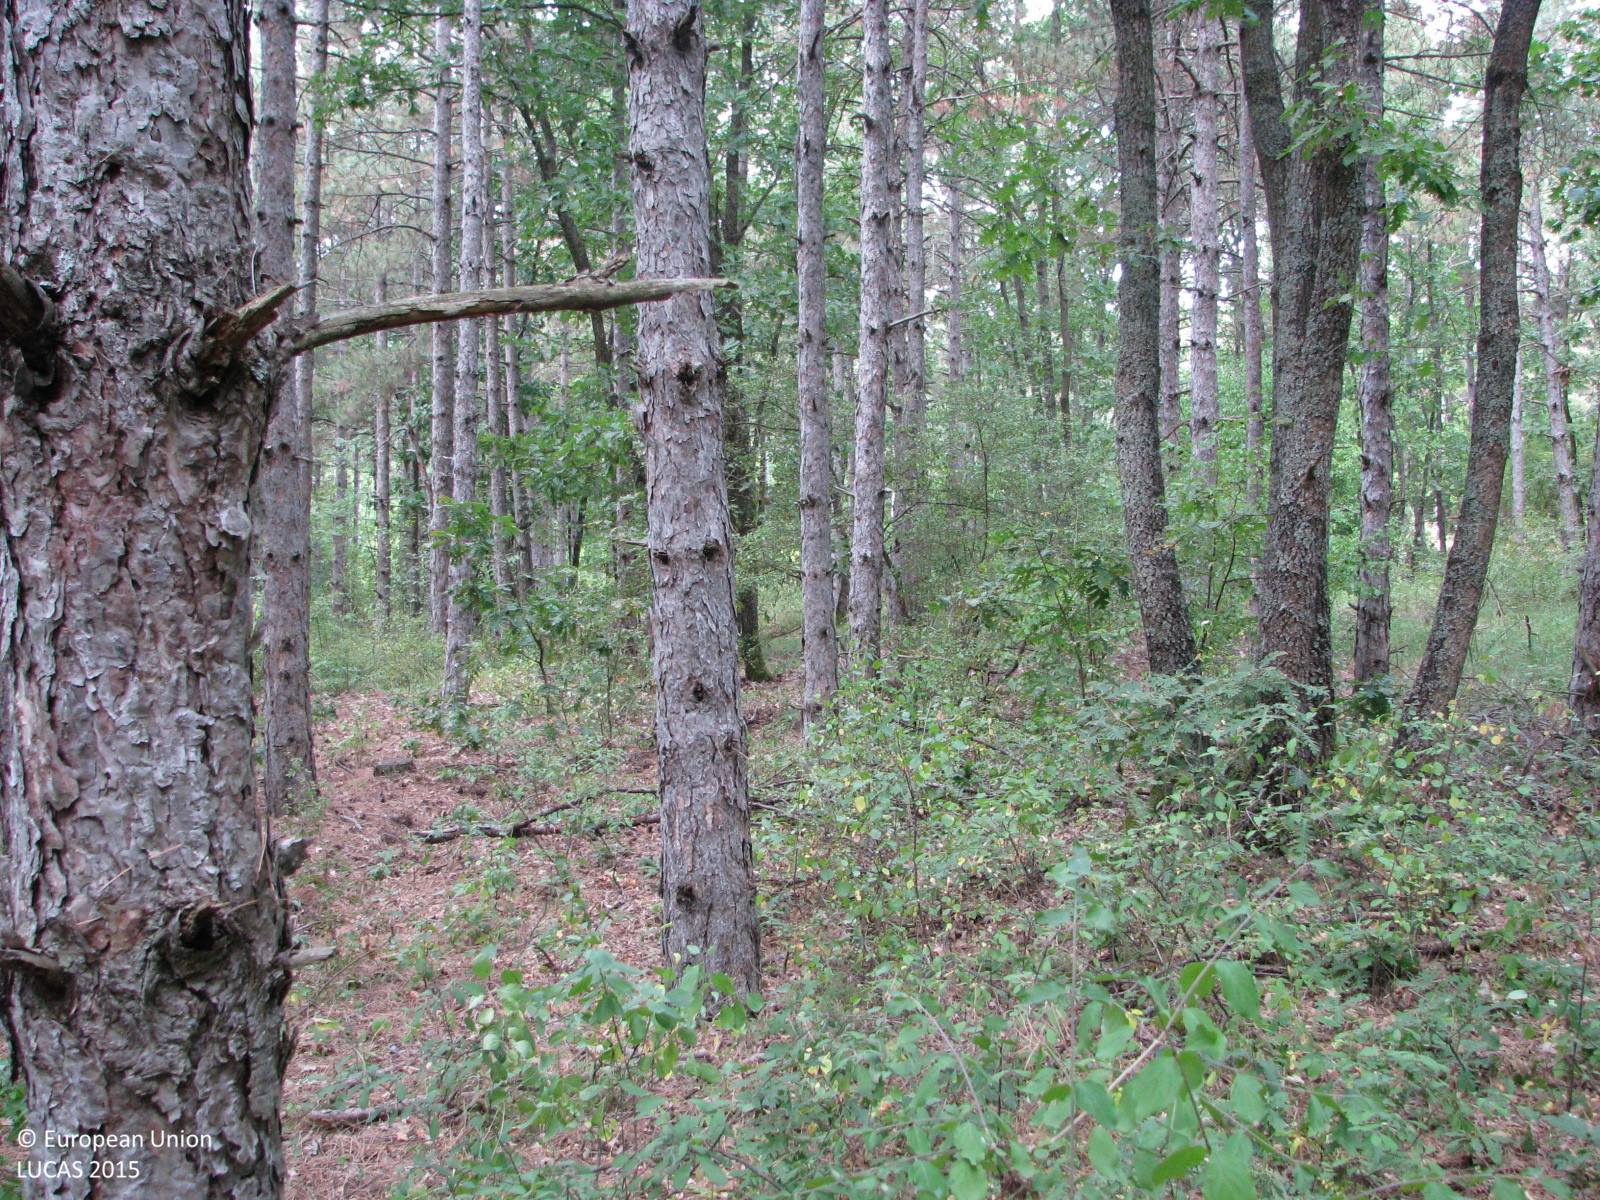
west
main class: Woodland
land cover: Pine dominated mixed woodland
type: hemiboreal forest and nemoral coniferous forest and mixed broadleaved-coniferous forest
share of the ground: > 75 %
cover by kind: coniferous forest trees 50 %, broadleaved forest trees 25 %, shrubs 15 %, herbaceous plants 10 %
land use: Forestry
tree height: > 5 m
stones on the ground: < 10 %
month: August
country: BG
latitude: 42.1051
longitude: 26.7942
